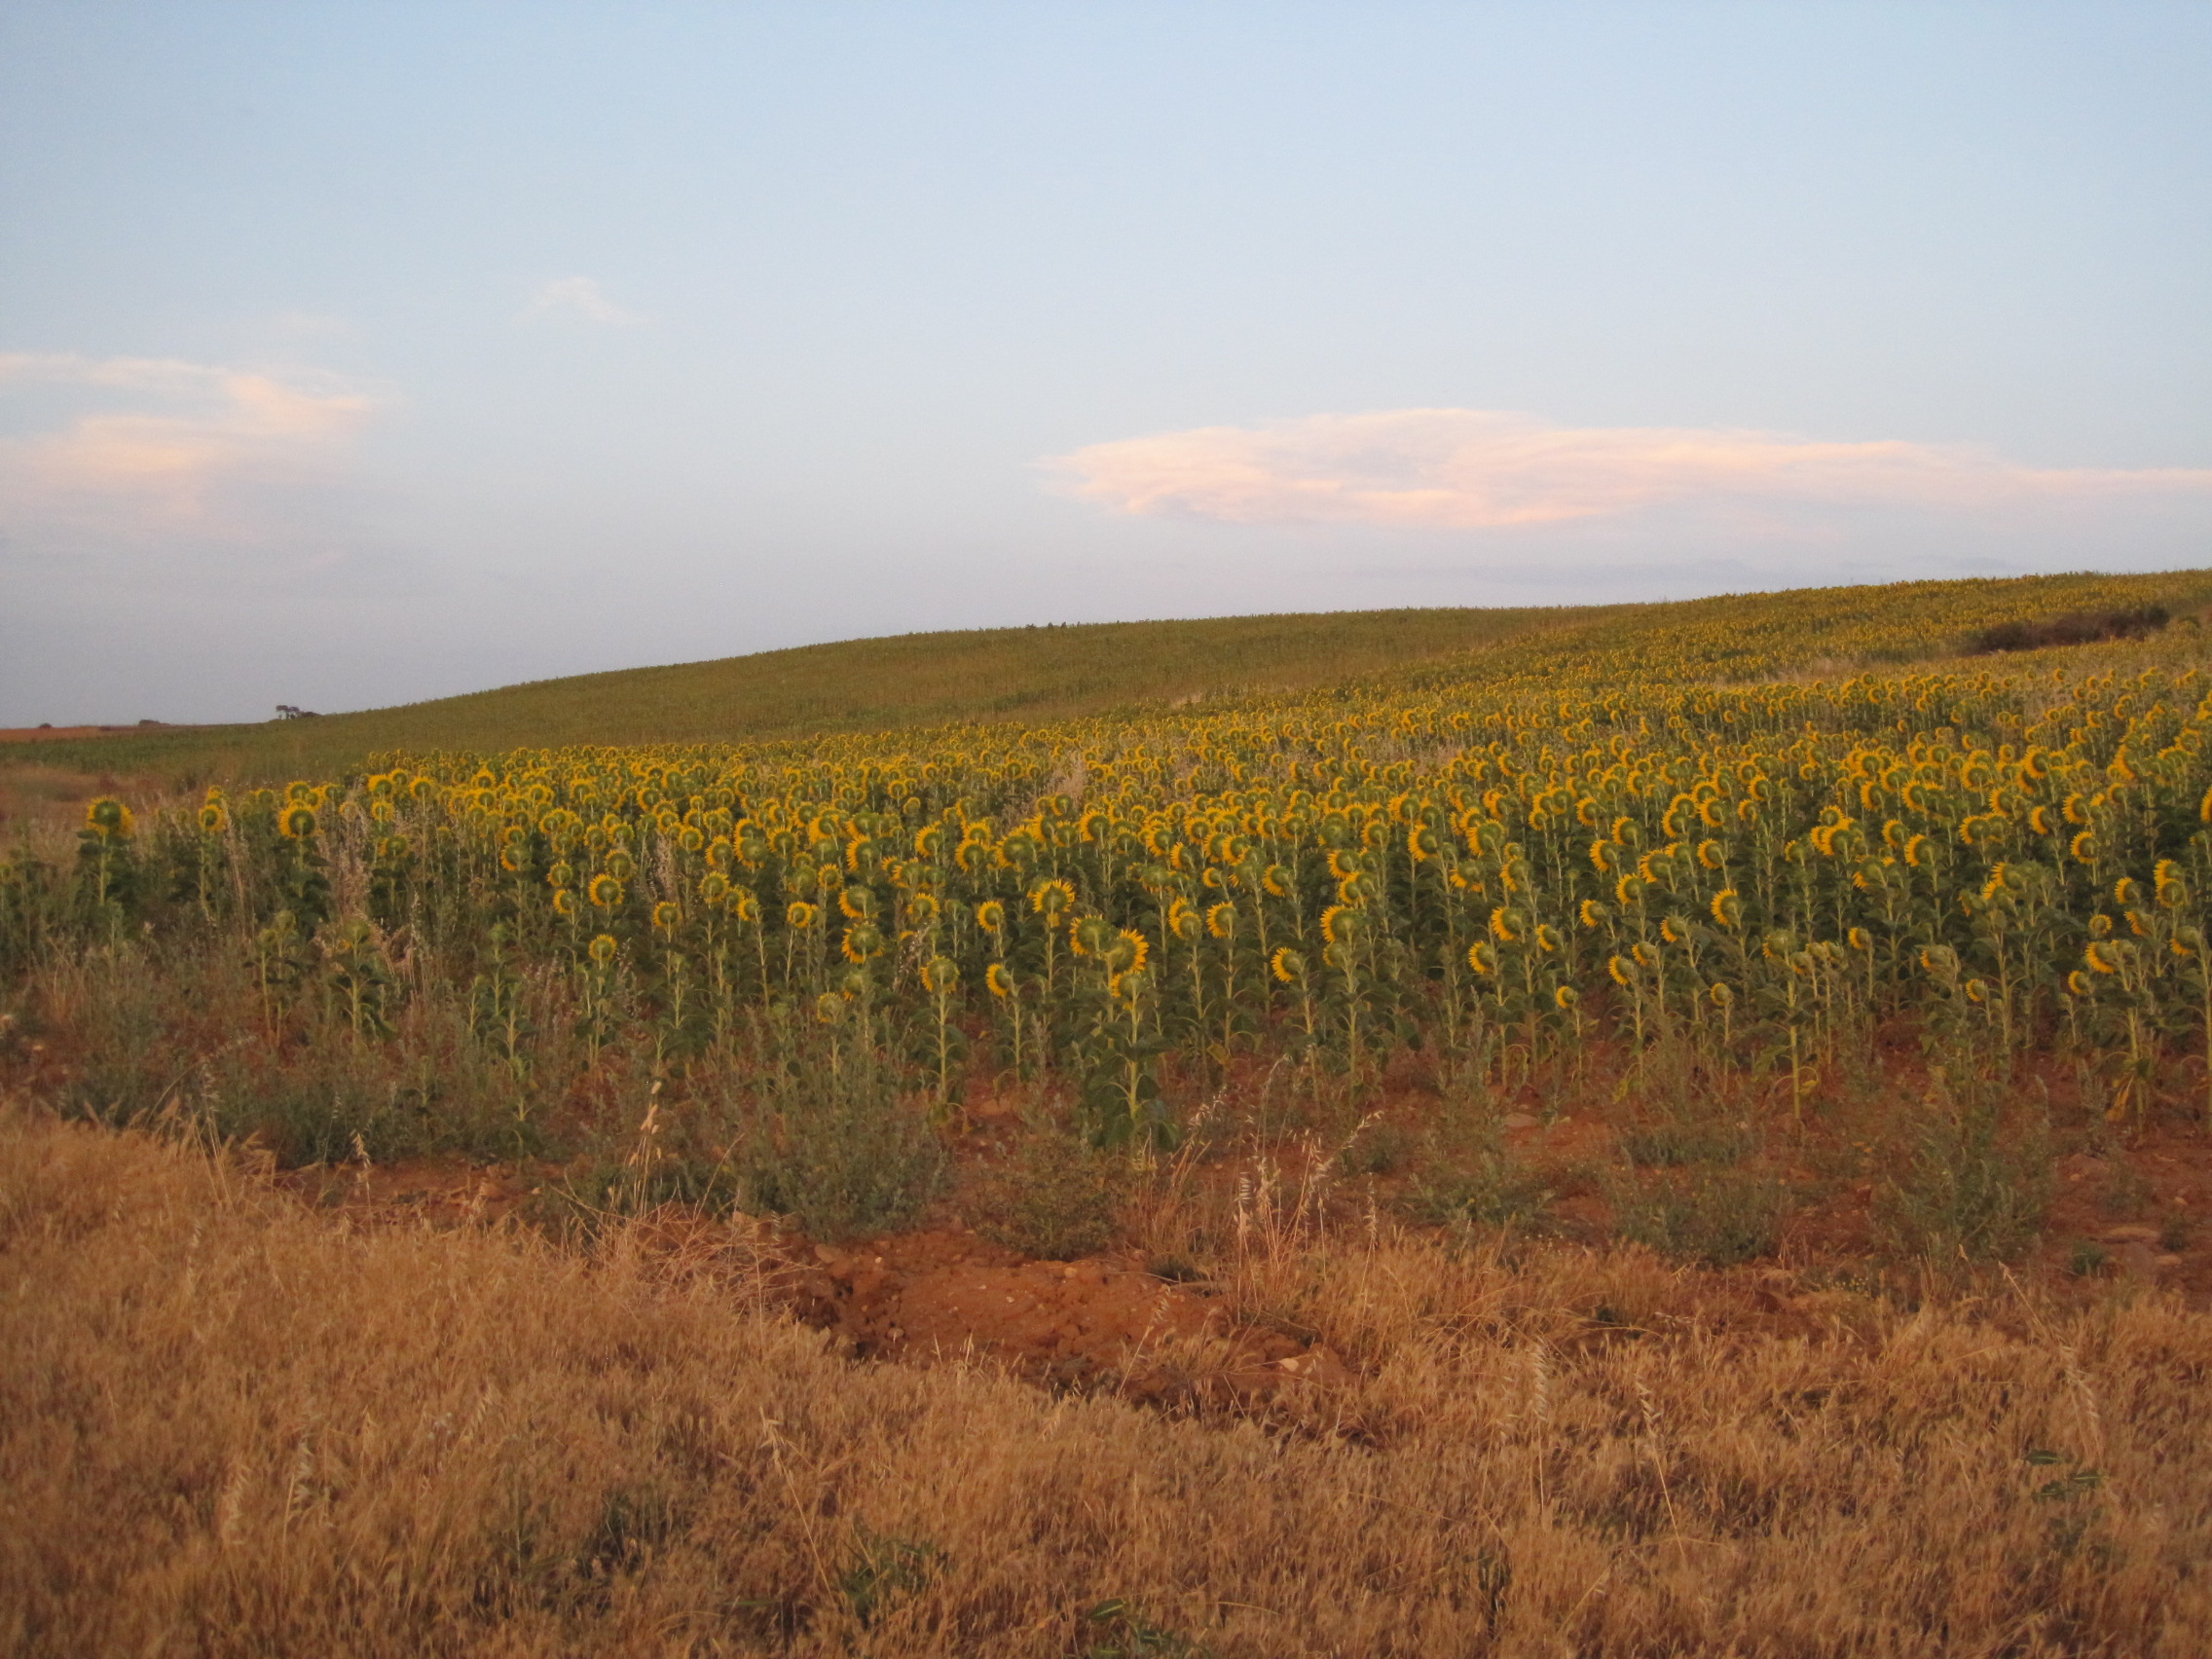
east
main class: Grassland
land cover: Grassland without tree/shrub cover
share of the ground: > 75 %
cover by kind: herbaceous plants 100 %
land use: Abandoned areas
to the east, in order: Grassland without tree/shrub cover; Sunflower; Grass margins; Sunflower
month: July
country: ES
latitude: 41.7655
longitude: -5.4937
